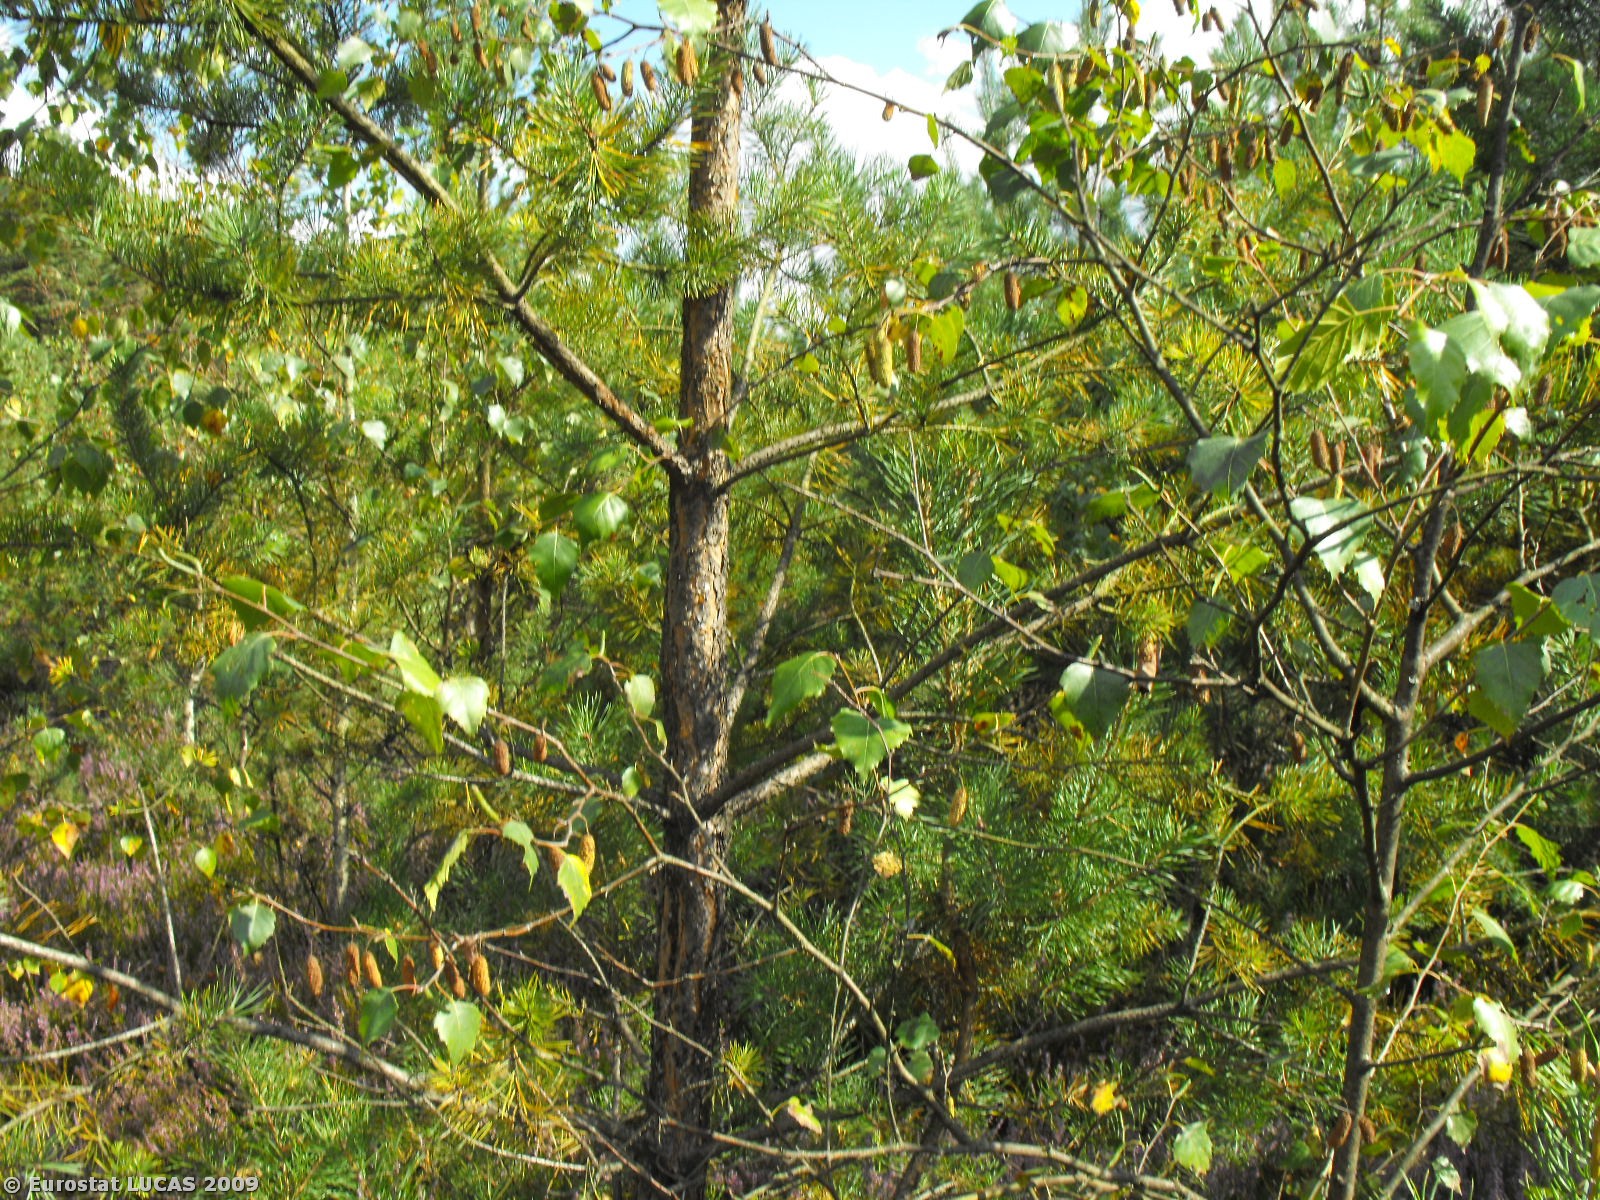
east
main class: Woodland
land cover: Coniferous woodland
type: hemiboreal forest and nemoral coniferous forest and mixed broadleaved-coniferous forest
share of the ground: > 75 %
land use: Forestry
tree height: > 5 m
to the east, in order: Coniferous woodland
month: September
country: PL
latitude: 52.7673
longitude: 16.3352
